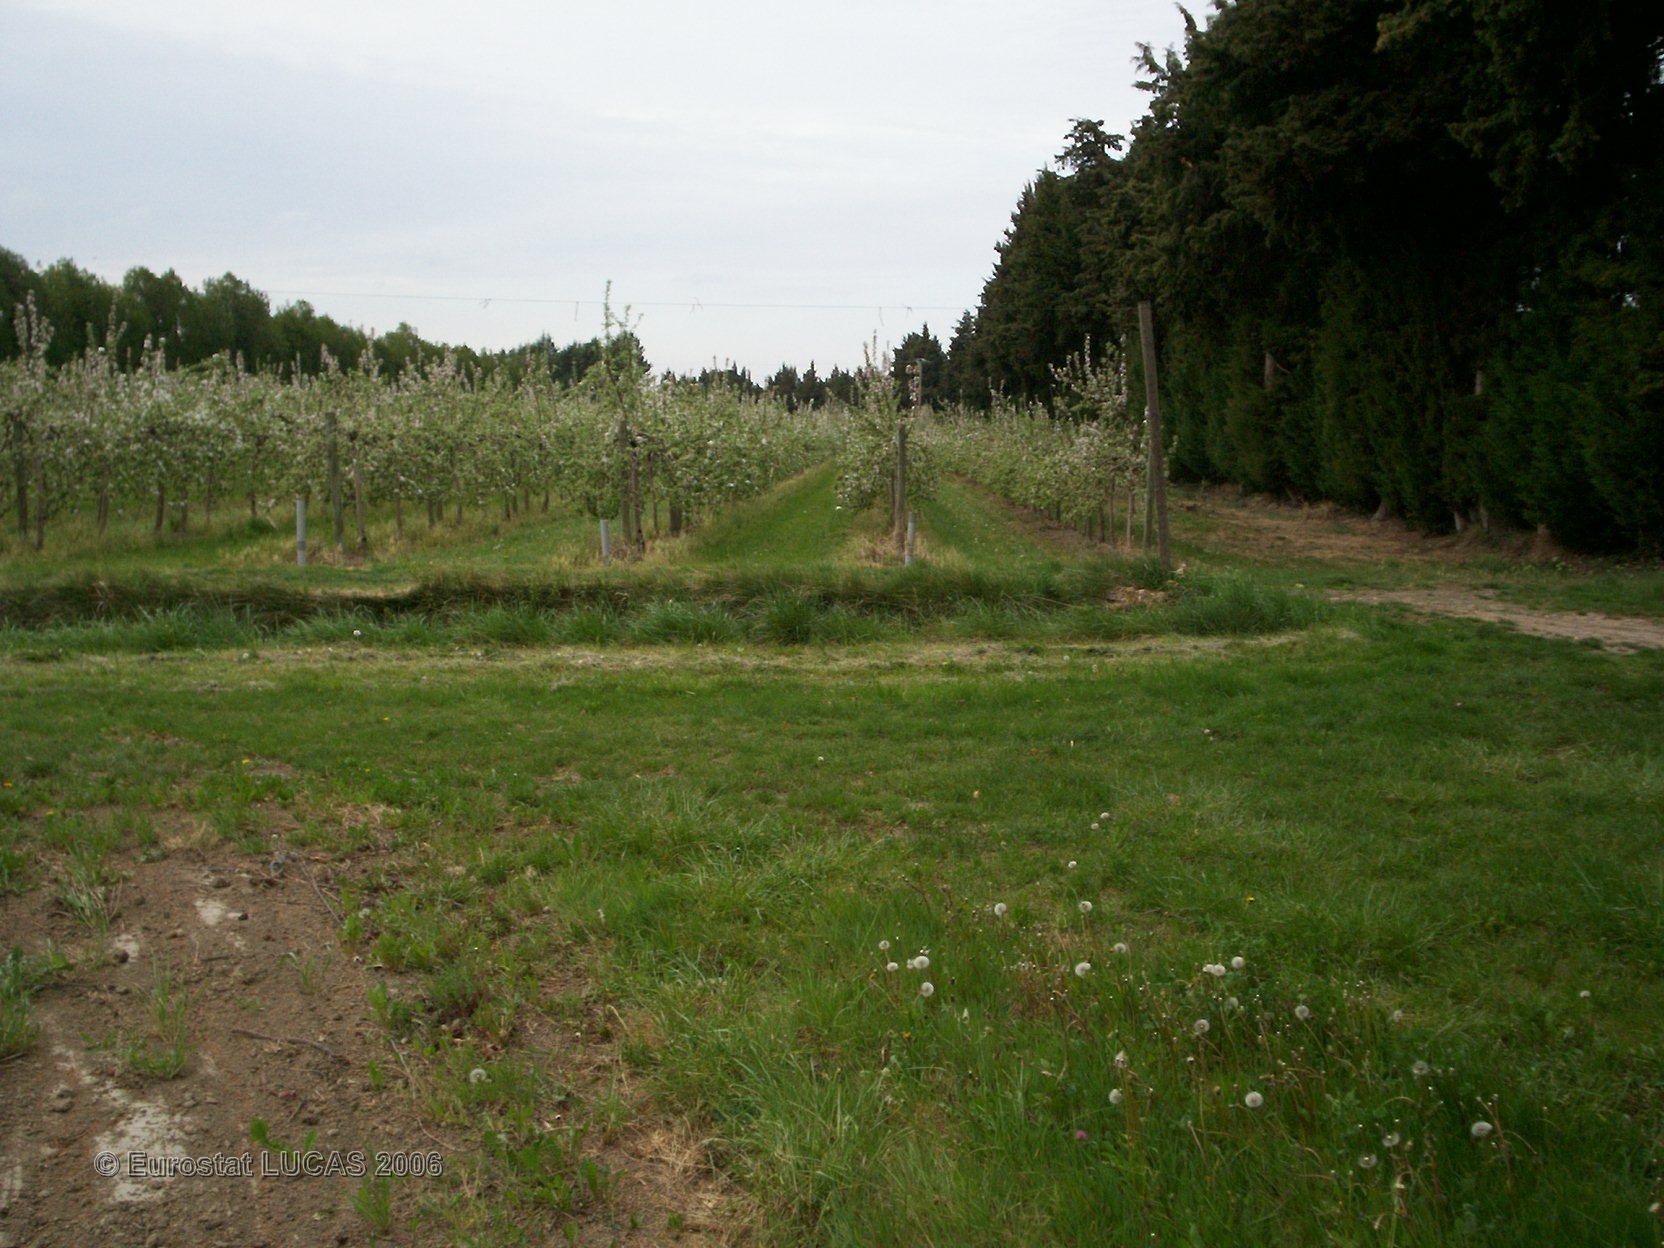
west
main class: Grassland
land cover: Grassland without tree/shrub cover
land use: Agriculture (excluding fallow land and kitchen gardens)
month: April
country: FR
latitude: 43.8312
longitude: 4.9725
